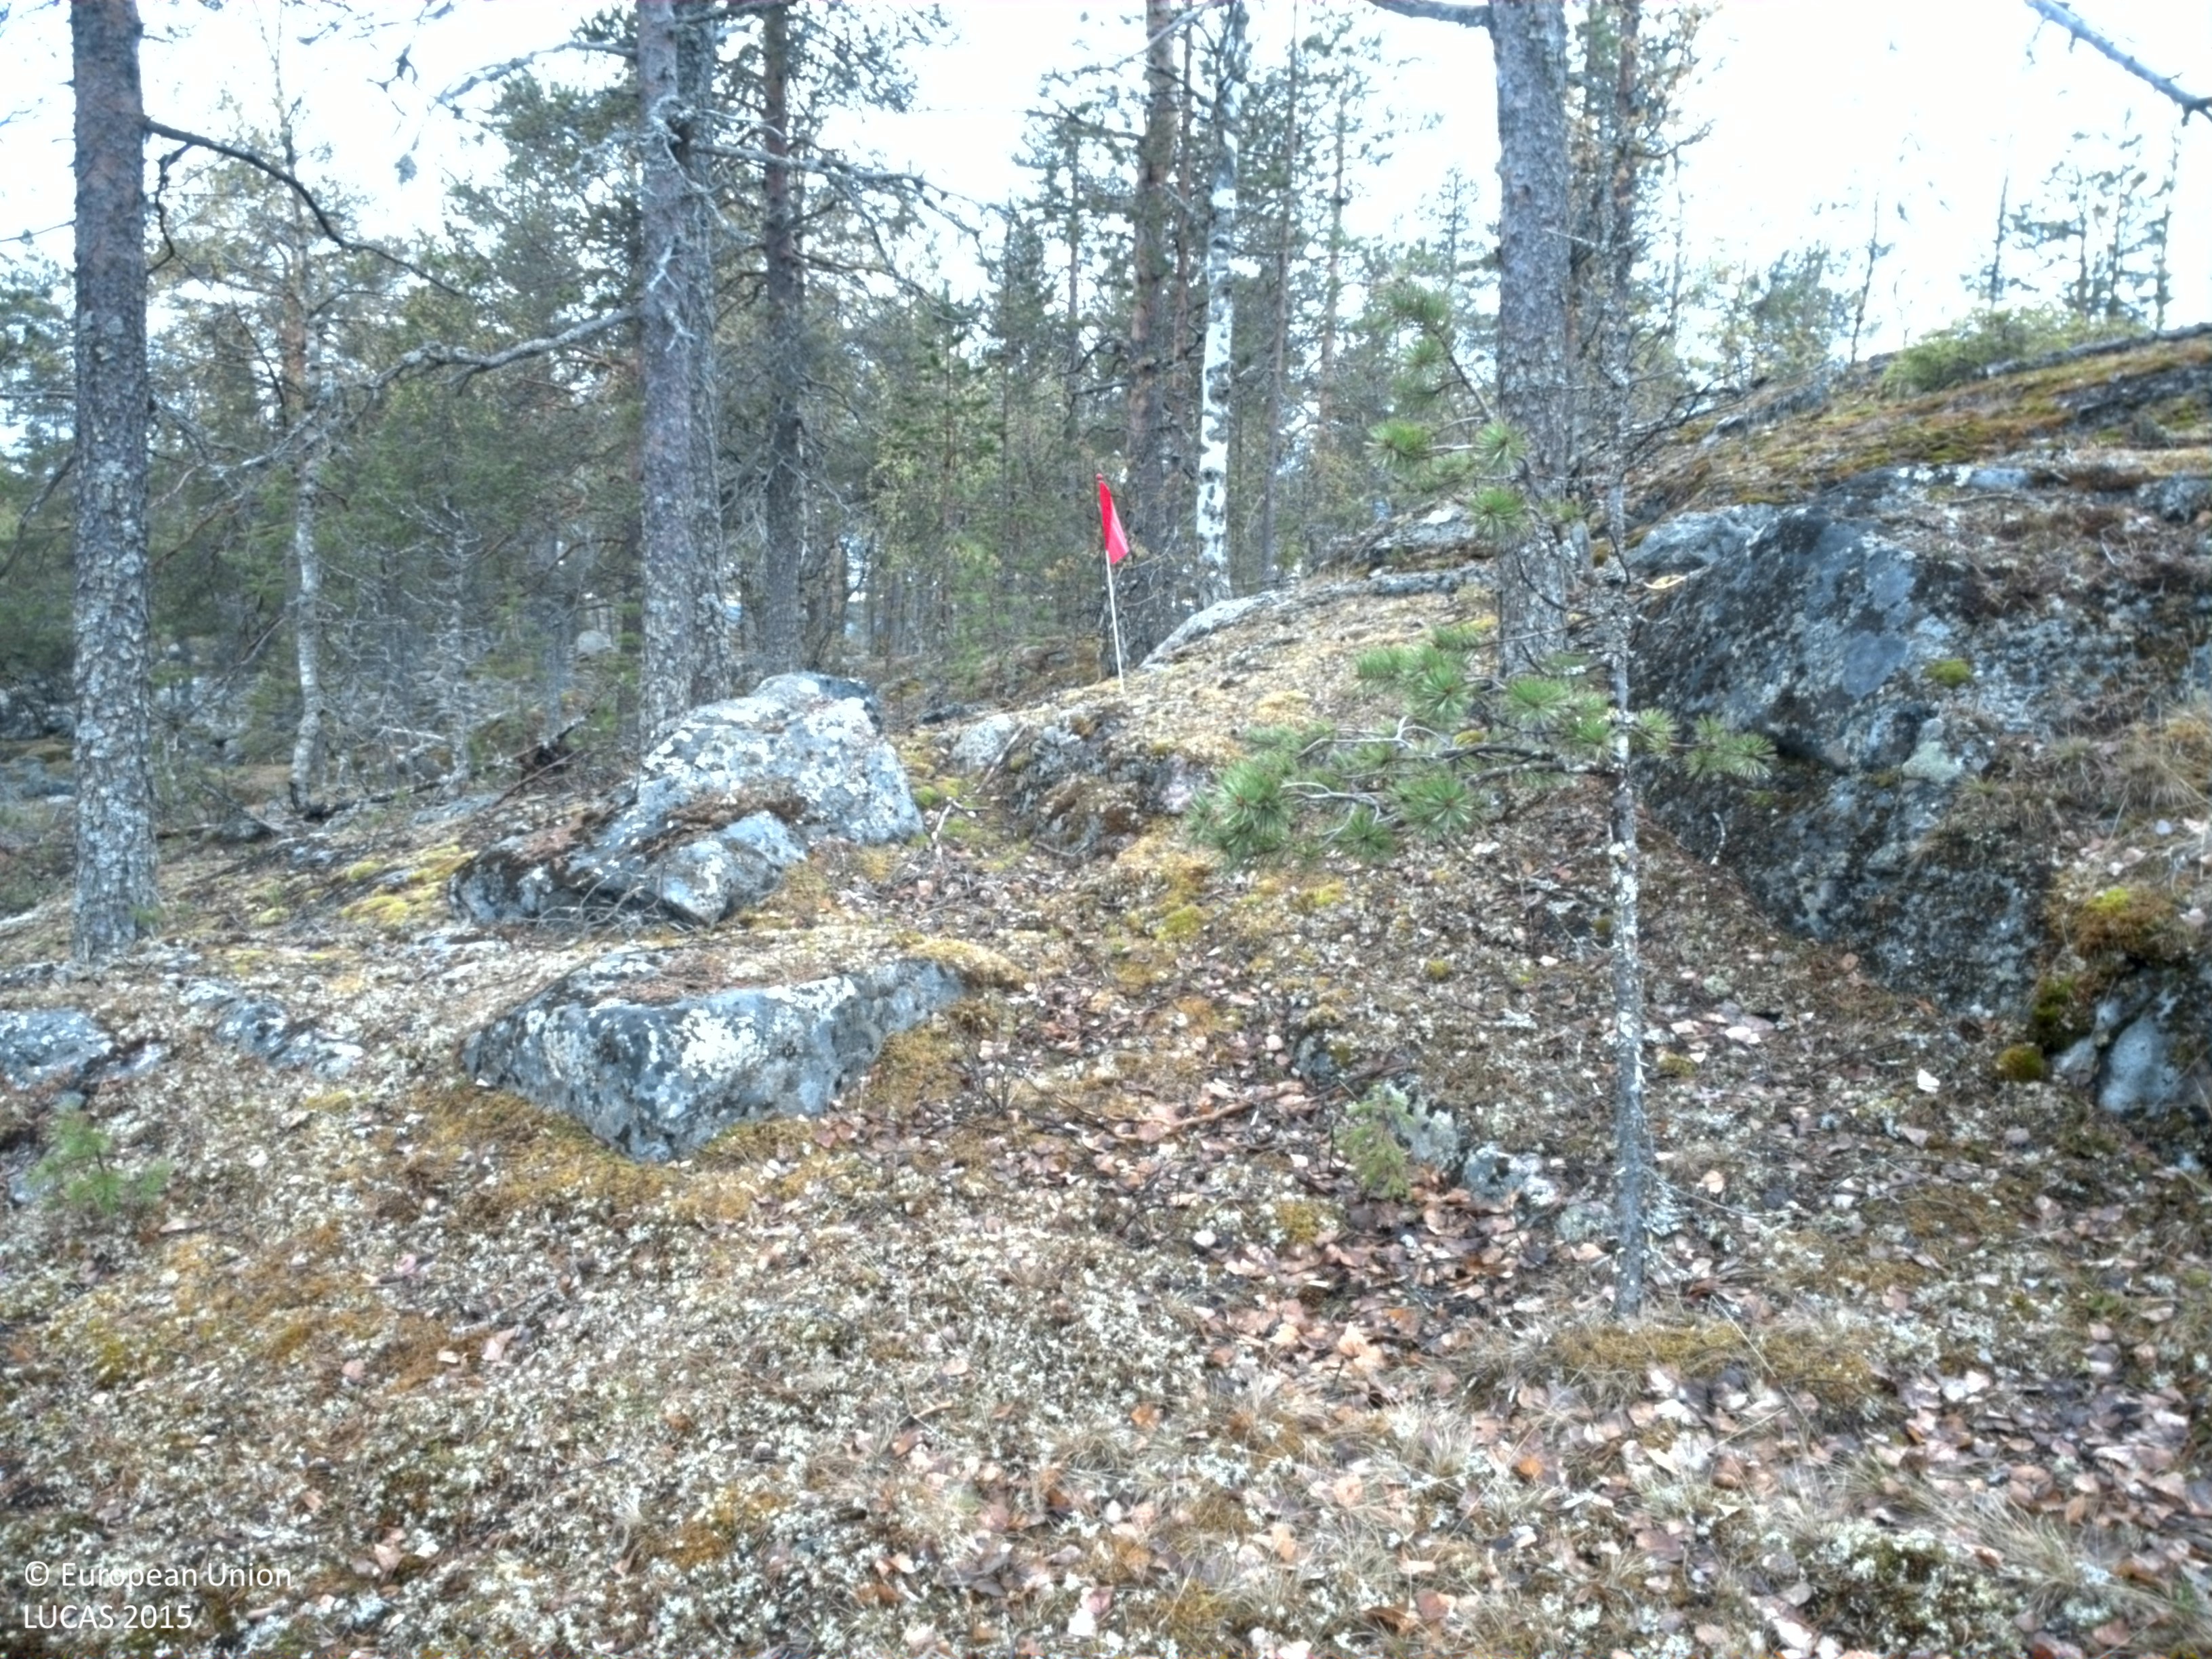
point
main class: Woodland
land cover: Pine dominated coniferous woodland
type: boreal forest
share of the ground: 25 - 50 %
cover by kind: coniferous forest trees 40 %, lichens and mosses 40 %, consolidated bare surface 10 %, broadleaved forest trees 5 %, shrubs 5 %
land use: Semi-natural and natural areas not in use
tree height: > 5 m
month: May
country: SE
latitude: 66.0593
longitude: 23.0806
